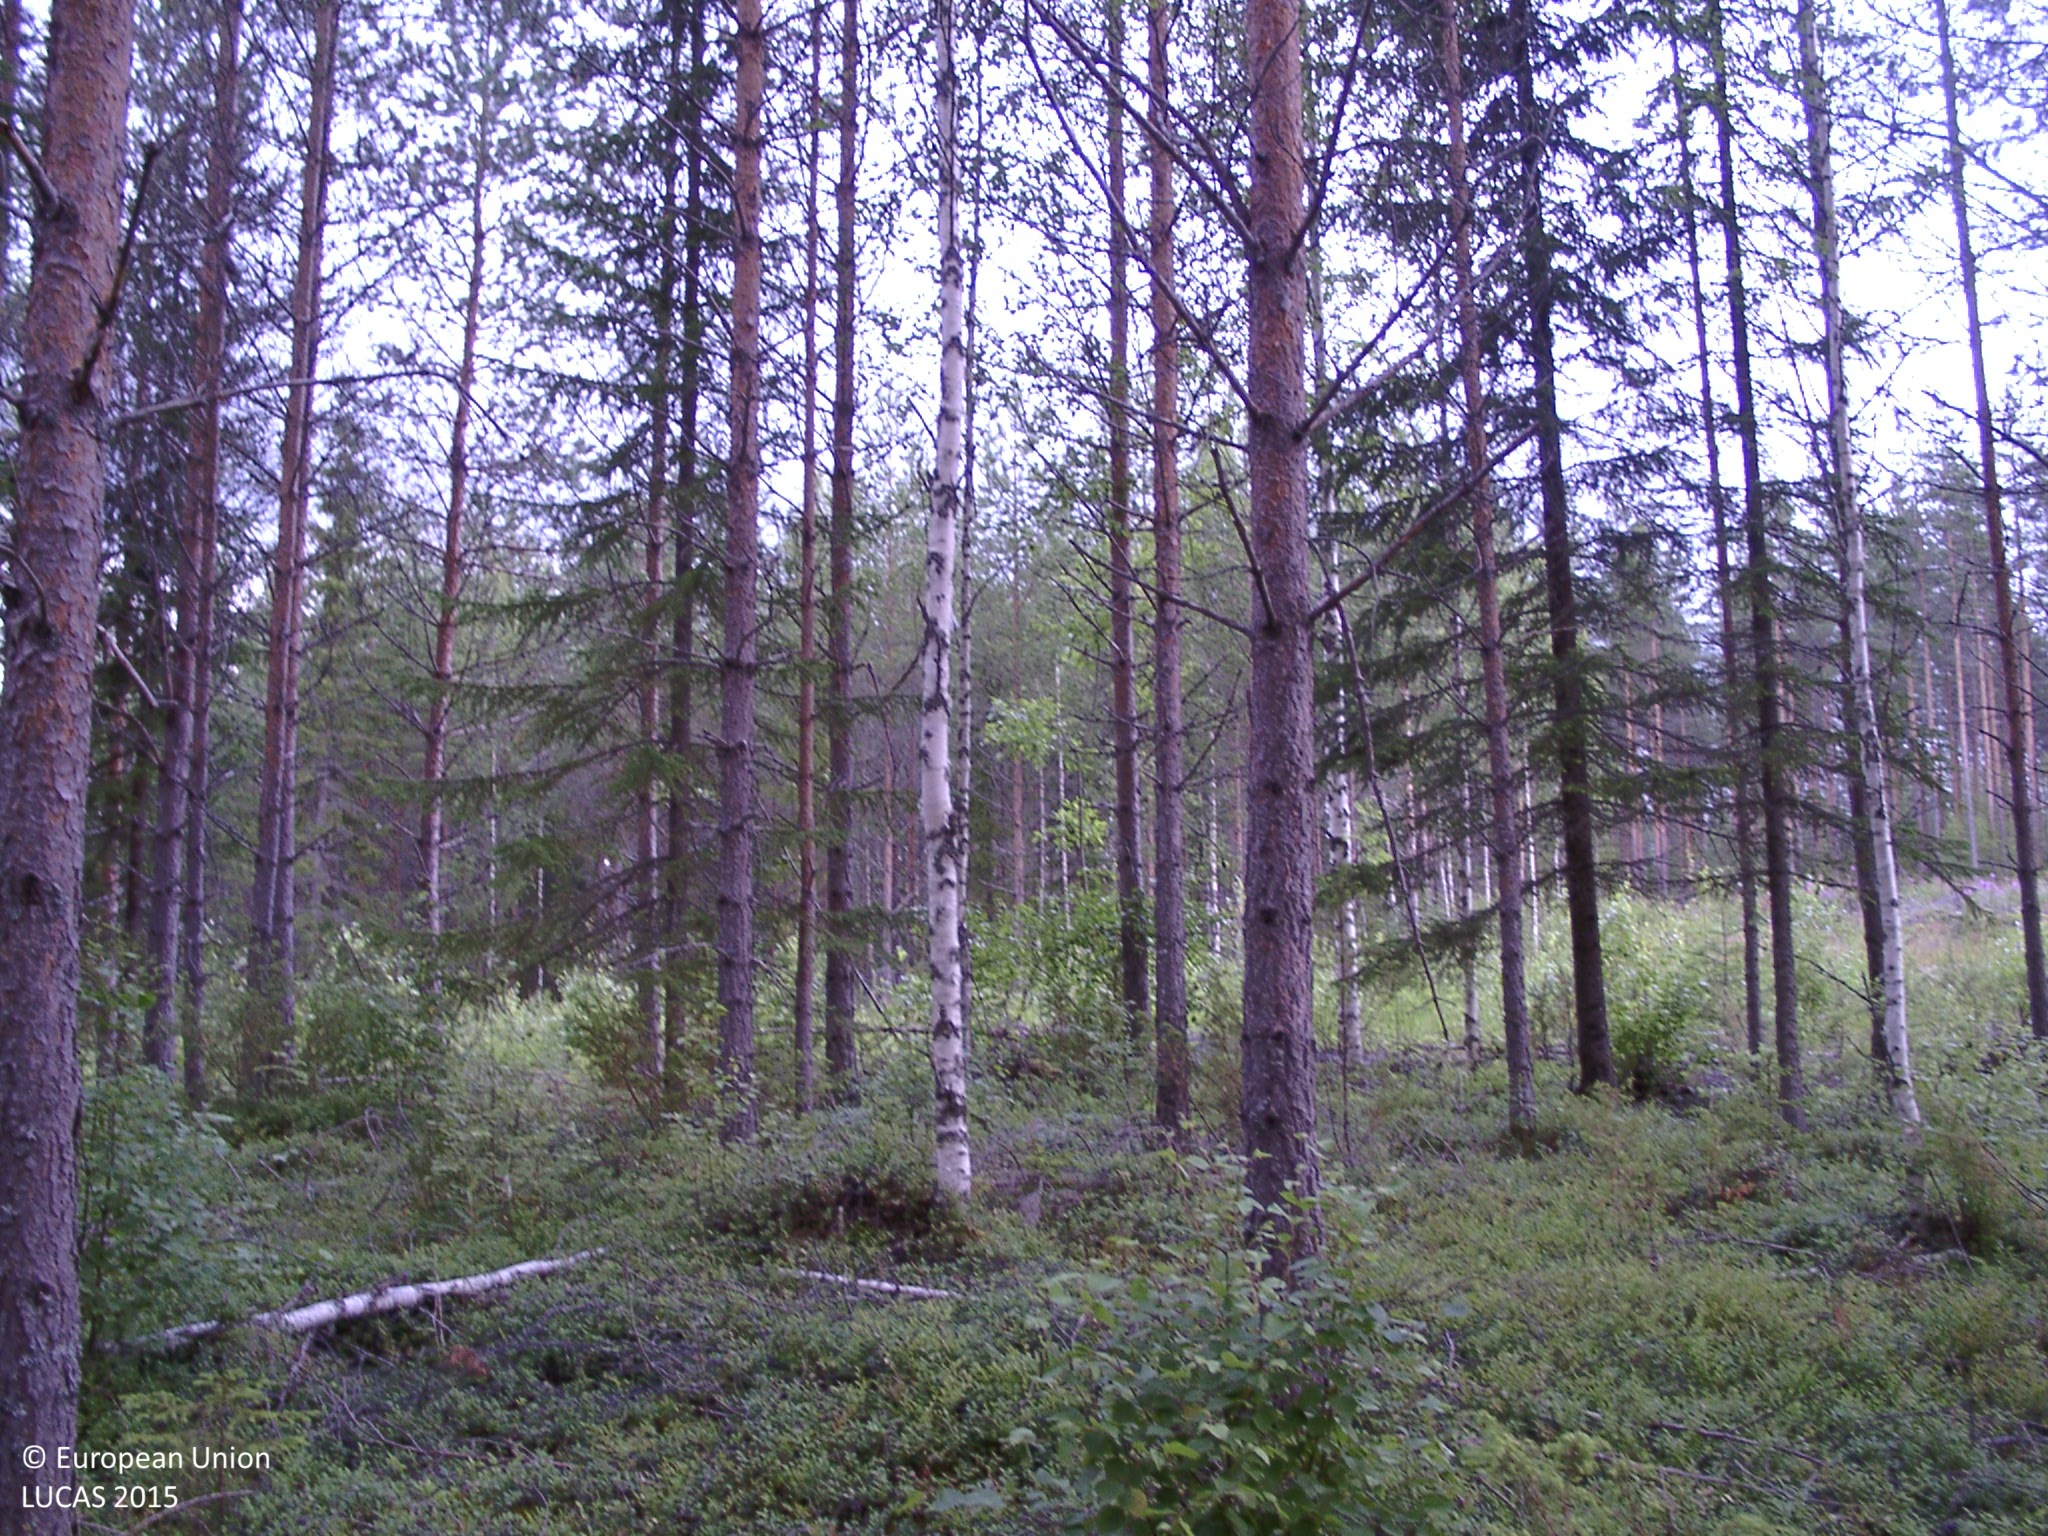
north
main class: Woodland
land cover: Other mixed woodland
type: boreal forest
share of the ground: 50 - 75 %
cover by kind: coniferous forest trees 45 %, broadleaved forest trees 25 %, shrubs 15 %, lichens and mosses 10 %, herbaceous plants 5 %
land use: Forestry
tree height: > 5 m
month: July
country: FI
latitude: 62.3157
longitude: 25.1743
